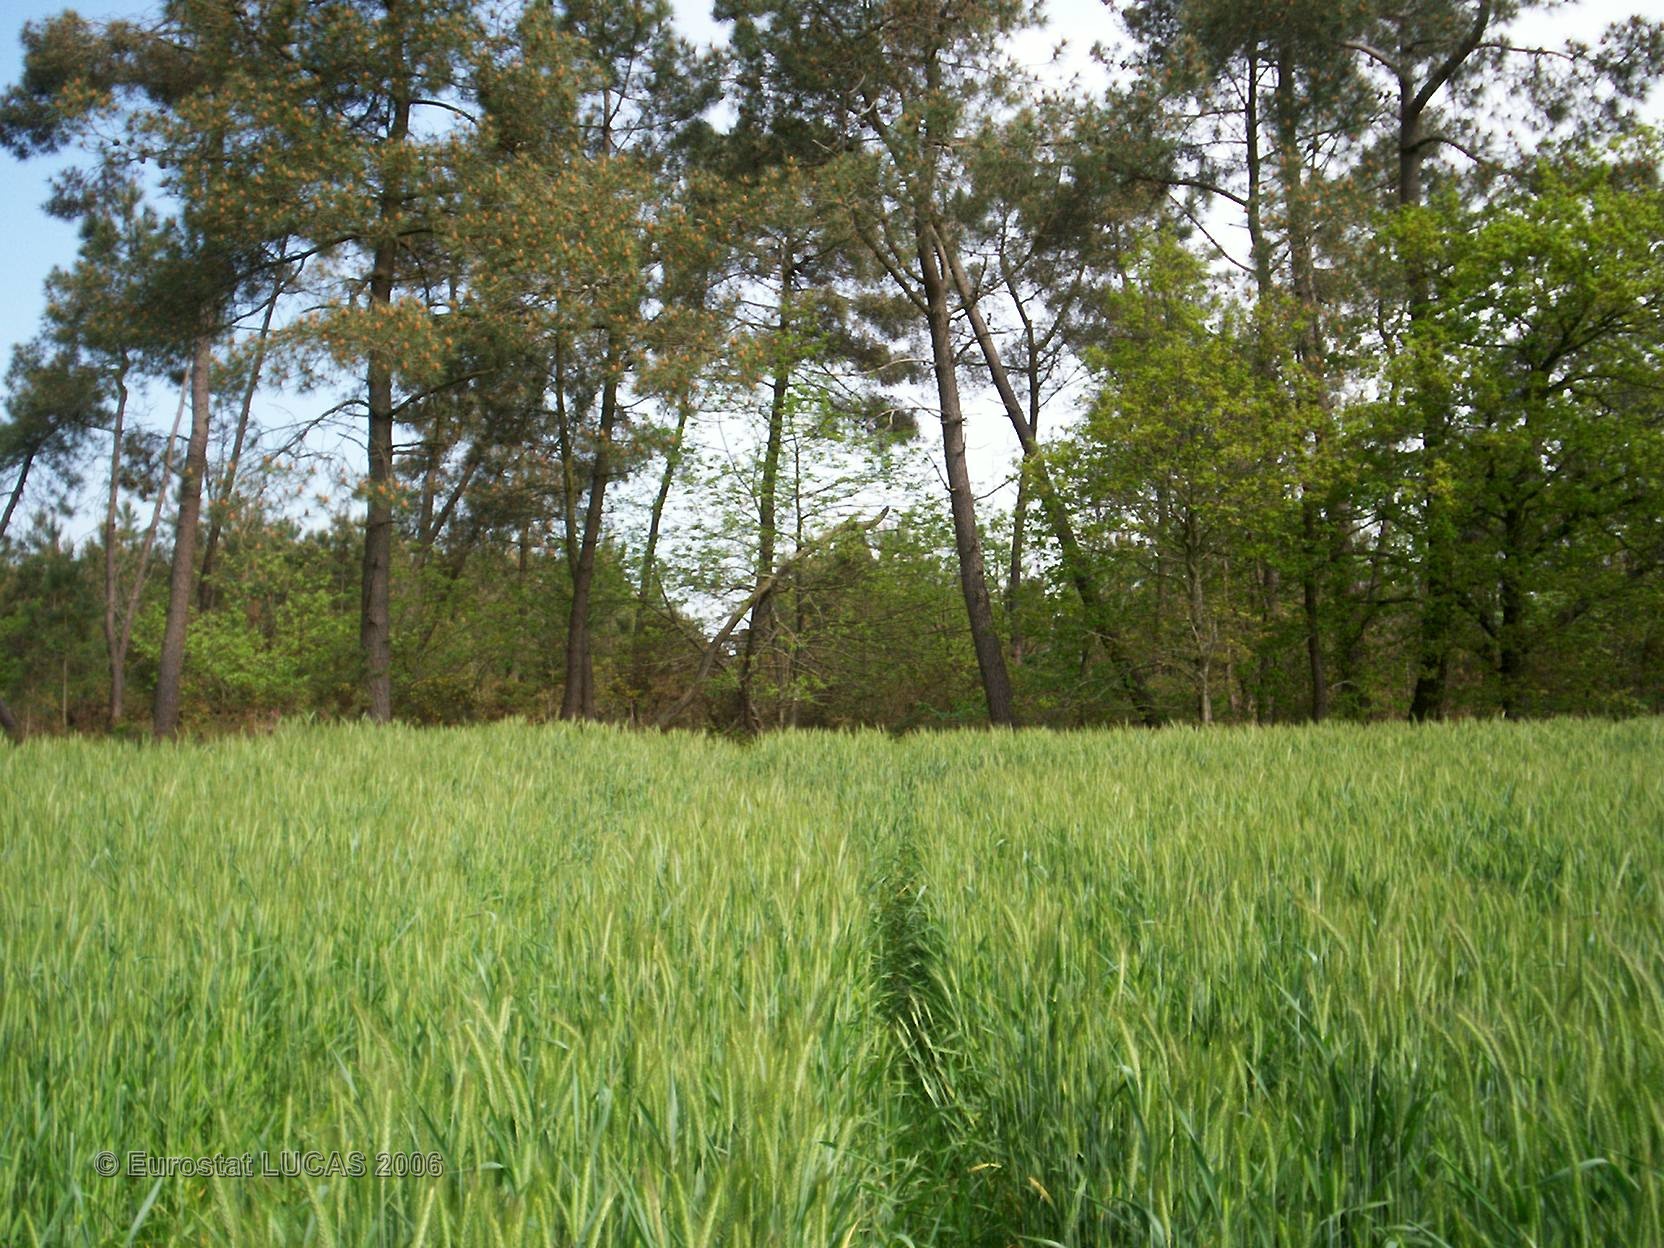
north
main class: Cropland
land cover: Common wheat
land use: Agriculture (excluding fallow land and kitchen gardens)
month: May
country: FR
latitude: 47.7987
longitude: -2.3525
